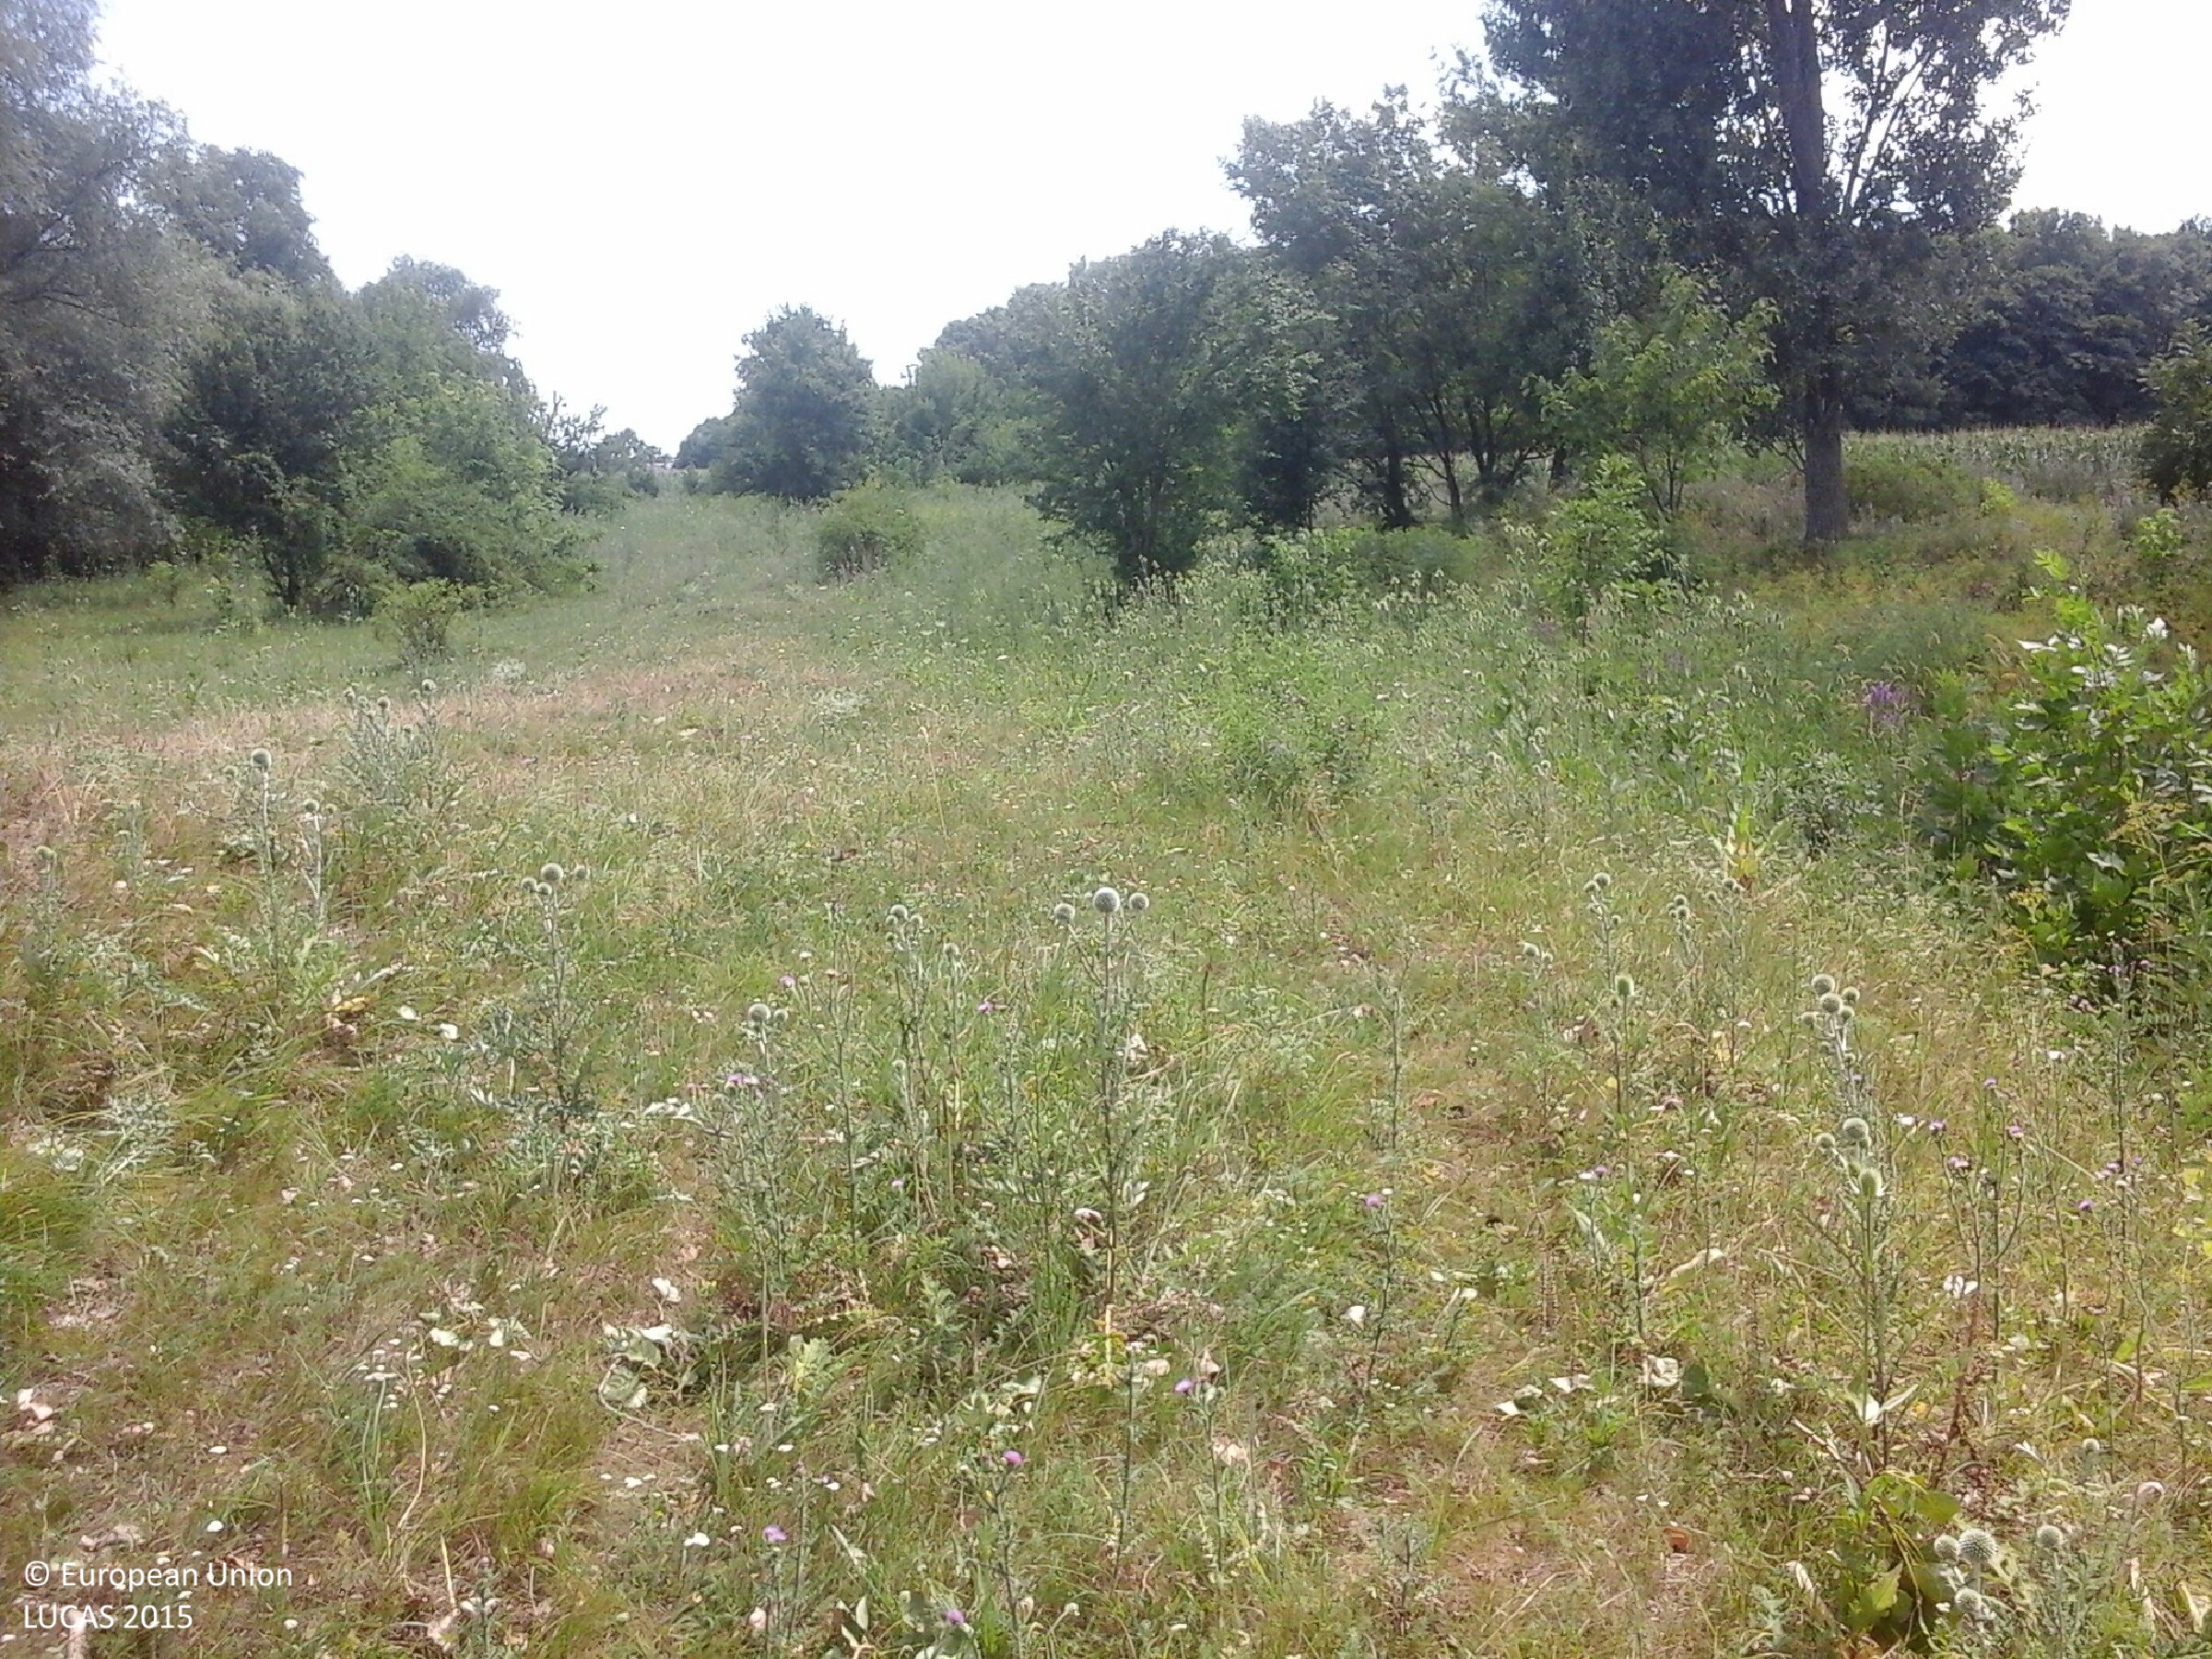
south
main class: Woodland
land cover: Broadleaved woodland
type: mesophytic deciduous forest
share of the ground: > 75 %
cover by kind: herbaceous plants 75 %, broadleaved forest trees 20 %, shrubs 5 %
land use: Semi-natural and natural areas not in use
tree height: < 5 m
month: July
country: HU
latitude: 47.8123
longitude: 20.6777
